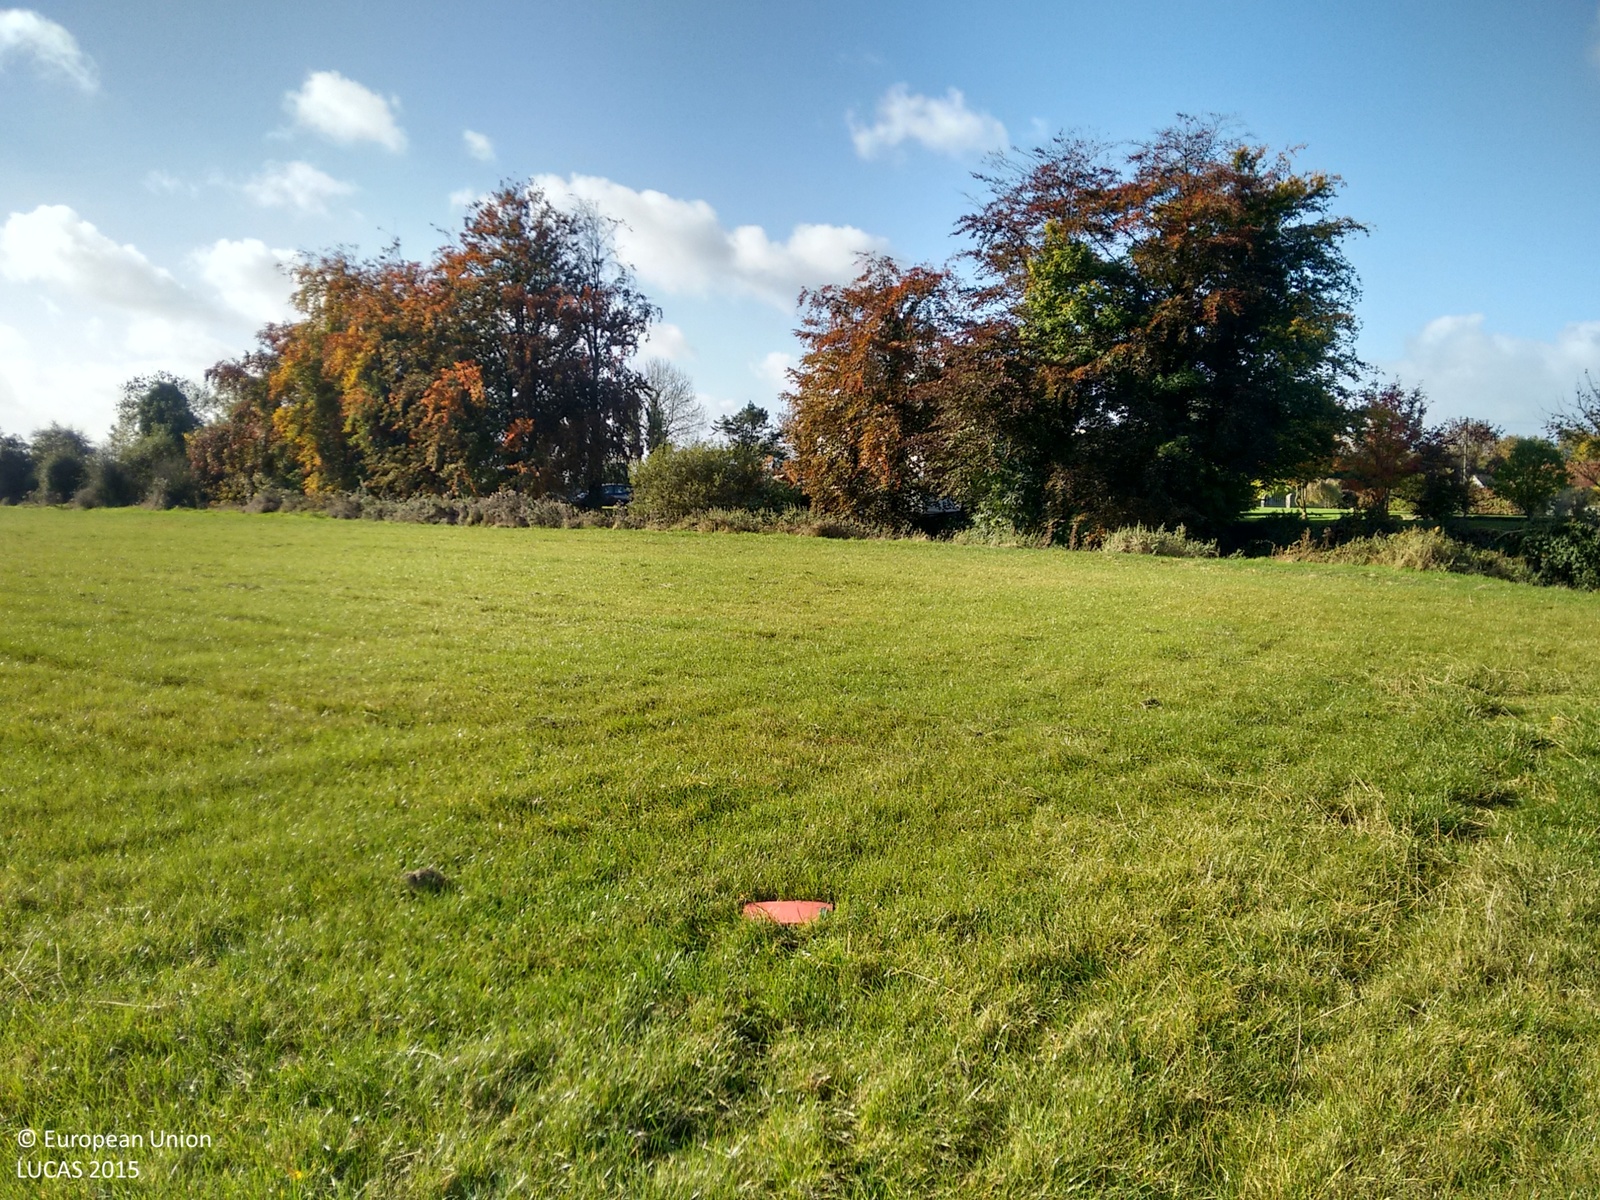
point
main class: Grassland
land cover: Grassland without tree/shrub cover
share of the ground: > 75 %
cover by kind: herbaceous plants 100 %
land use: Agriculture (excluding fallow land and kitchen gardens)
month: October
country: IE
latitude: 52.8038
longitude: -7.8060
